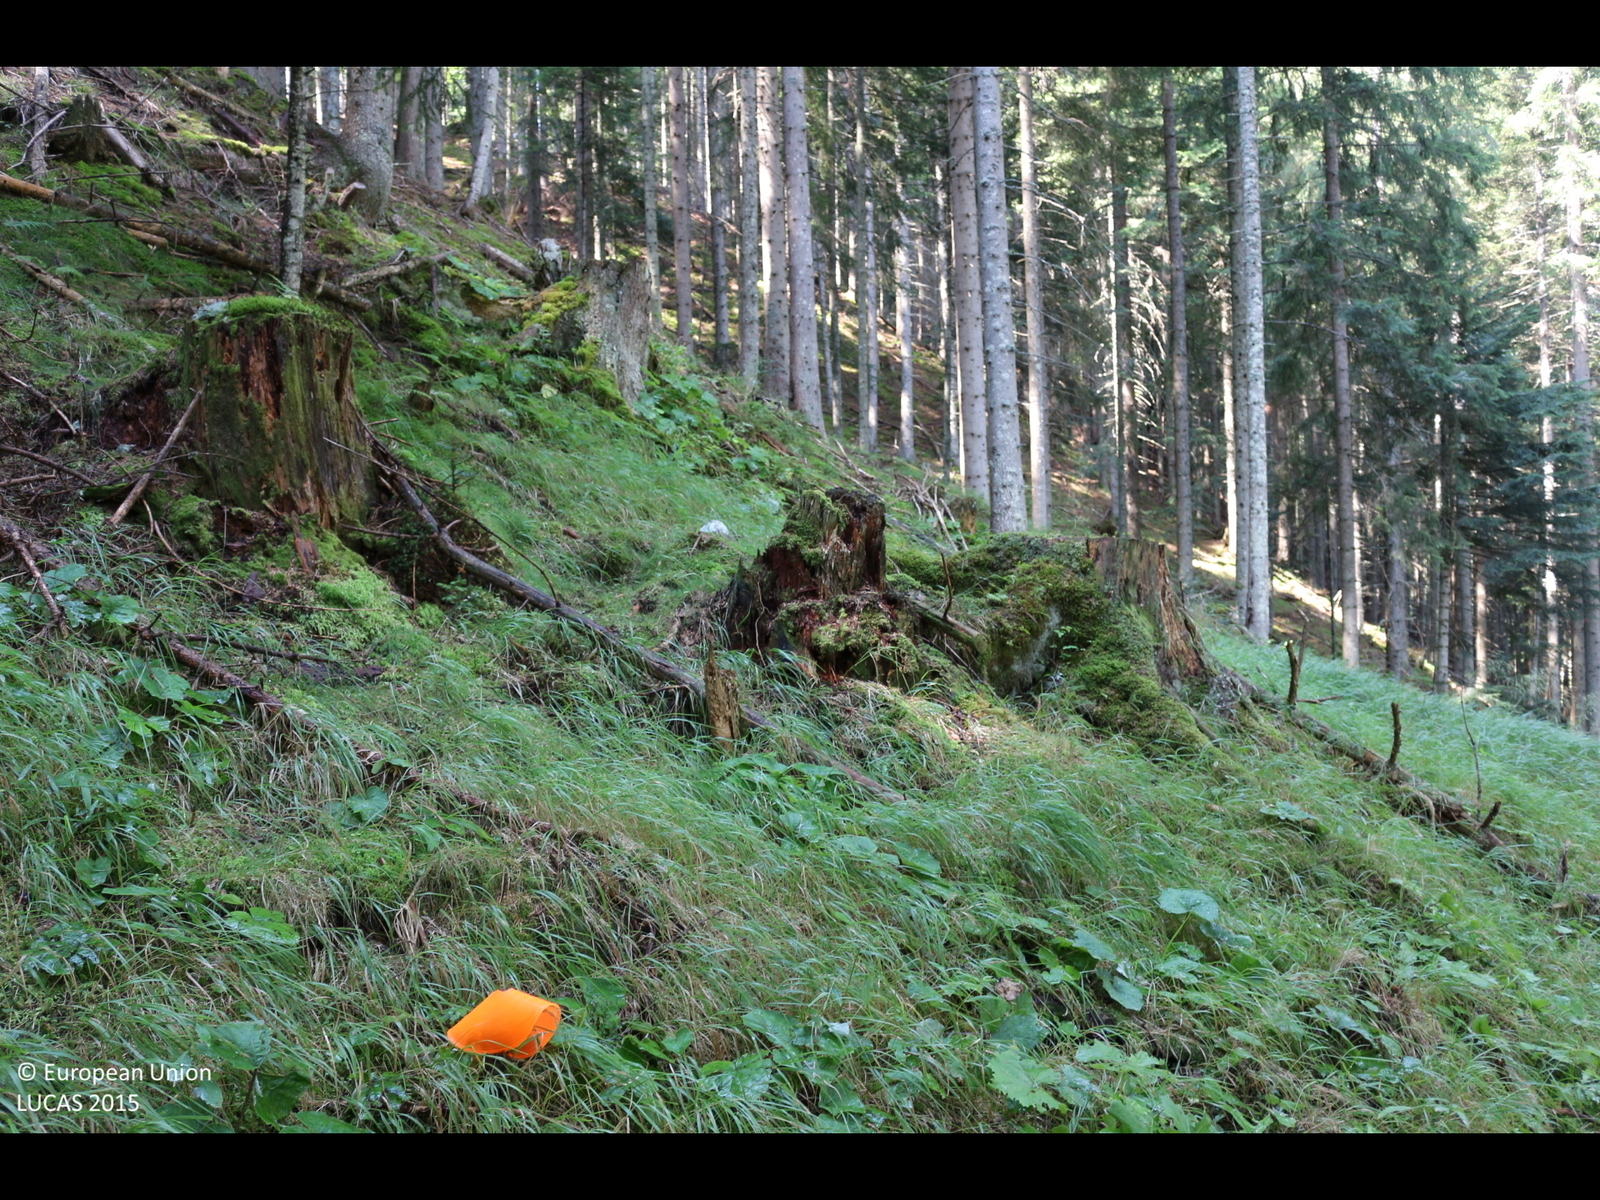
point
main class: Woodland
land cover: Spruce dominated coniferous woodland
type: alpine coniferous forest
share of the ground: > 75 %
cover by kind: coniferous forest trees 85 %, herbaceous plants 15 %
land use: Forestry
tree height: > 5 m
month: August
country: AT
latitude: 46.7646
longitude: 13.9649
